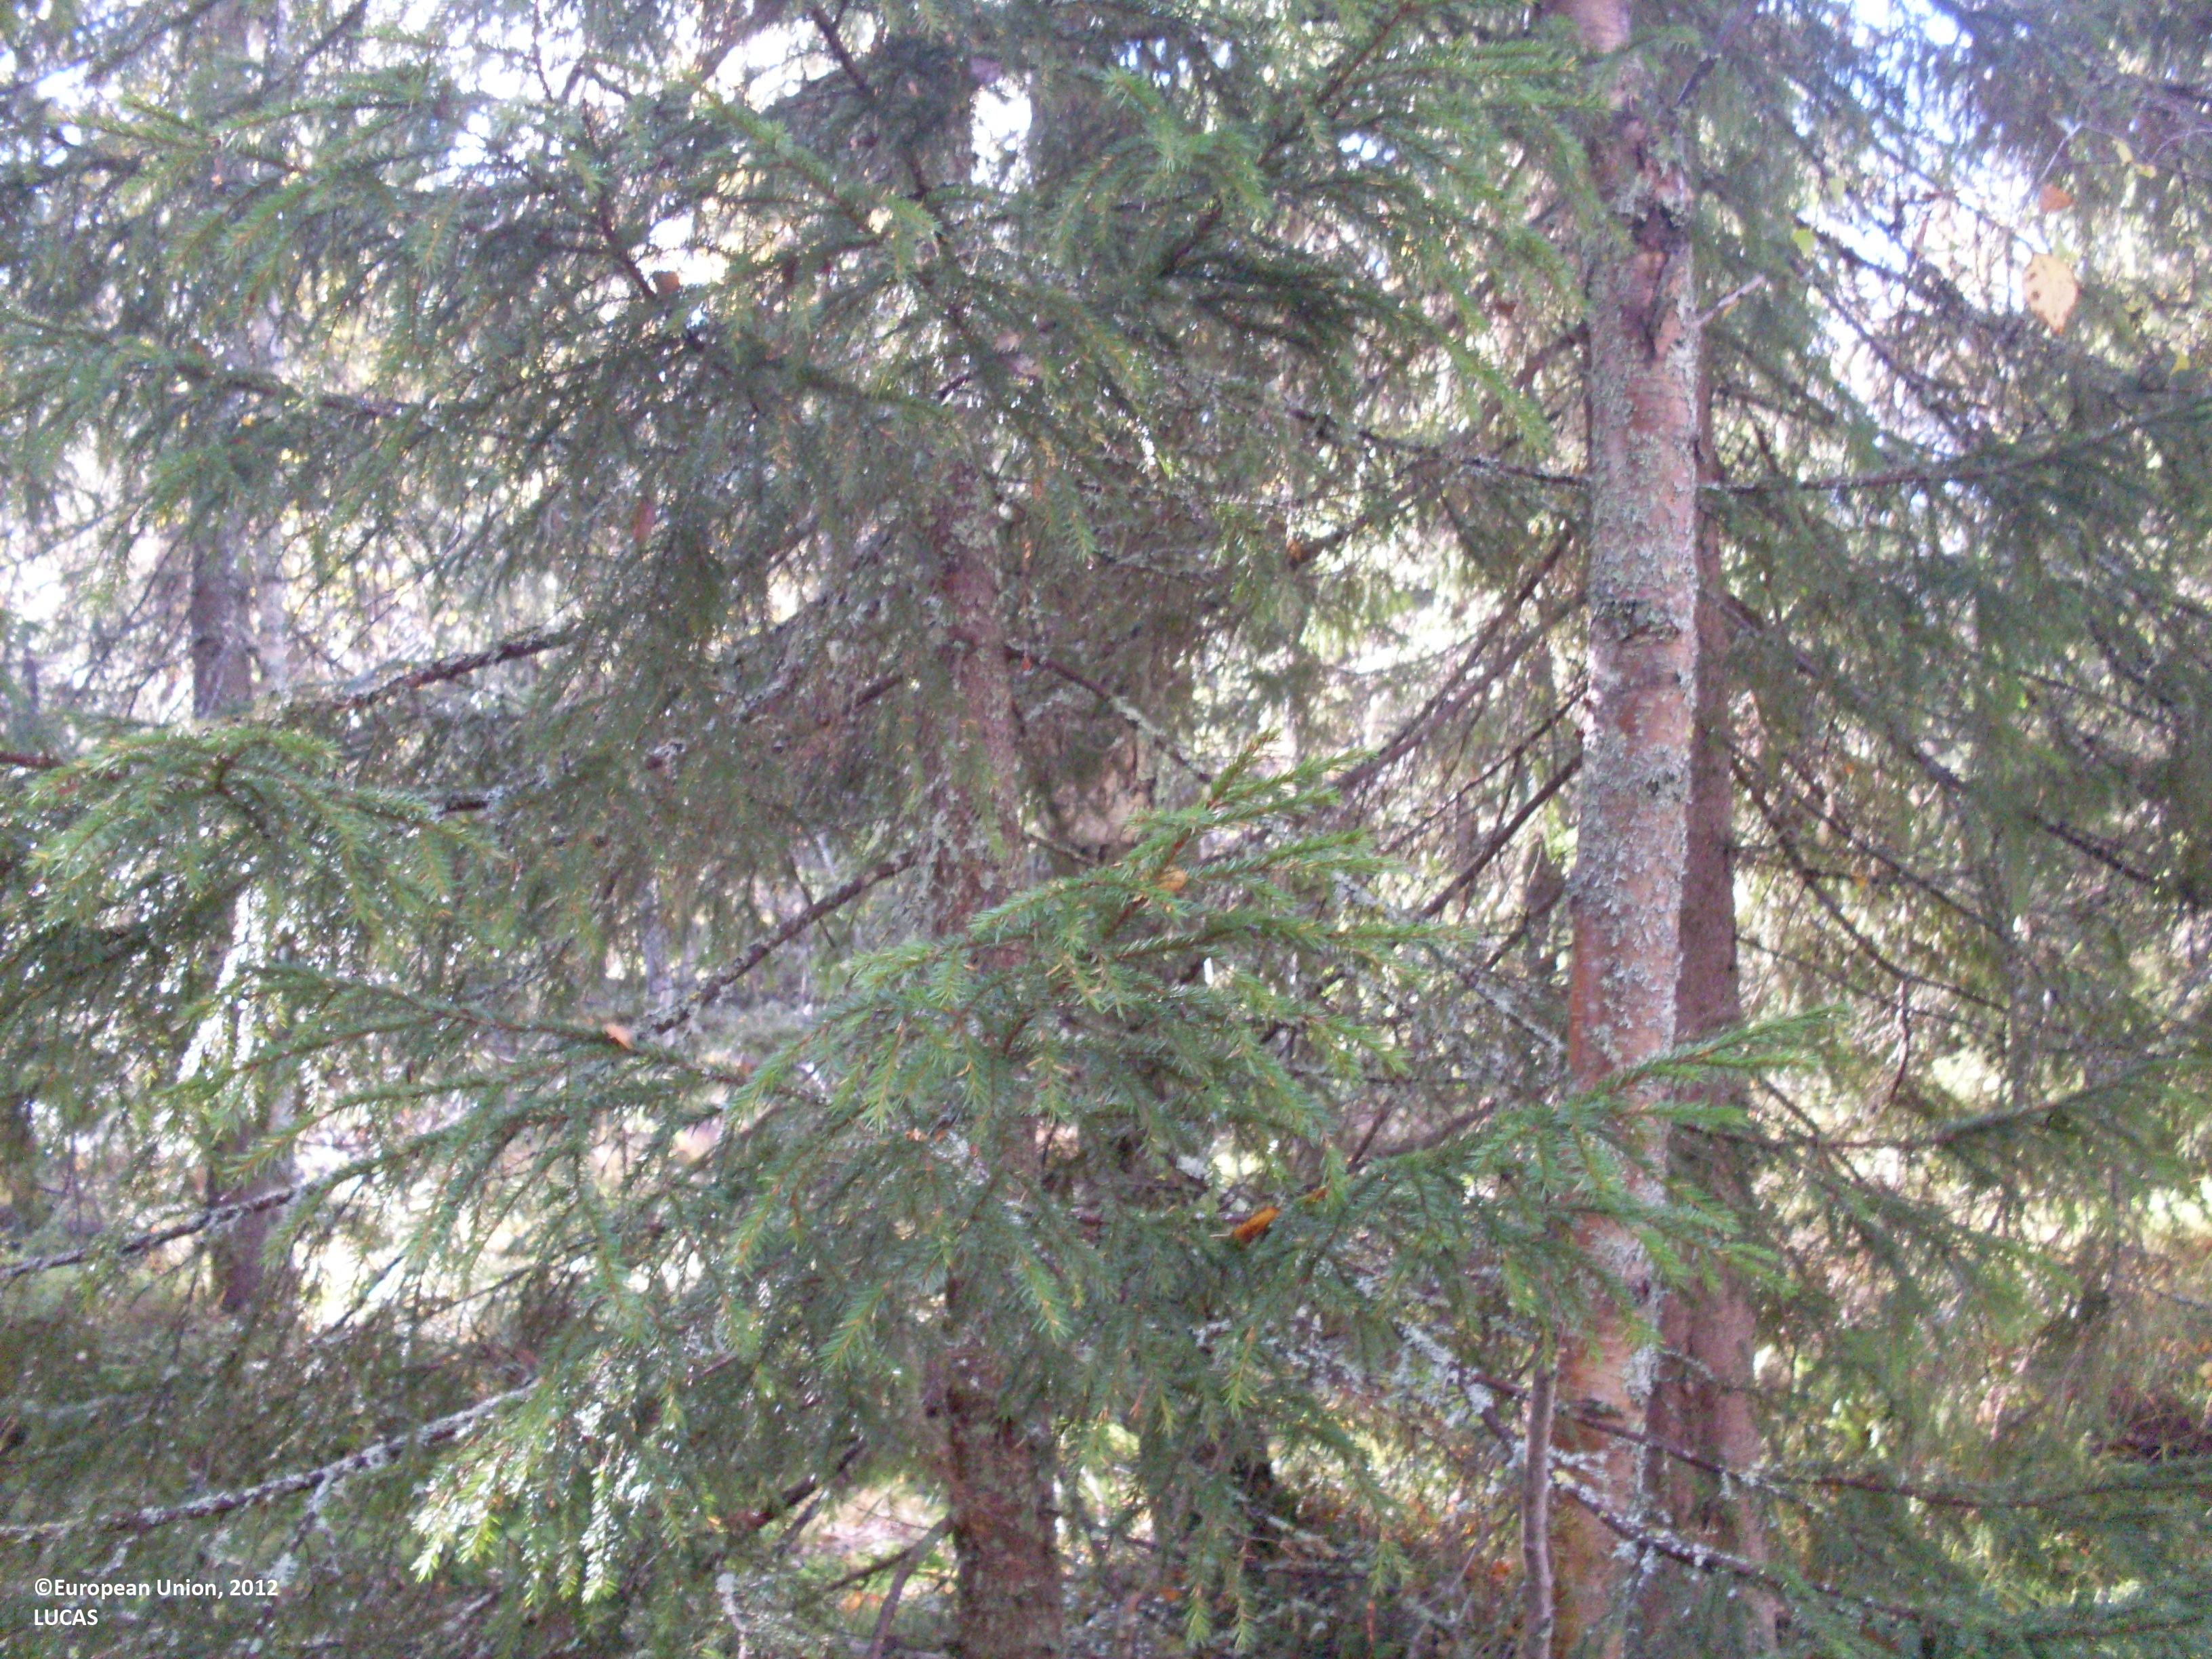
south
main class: Woodland
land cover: Spruce dominated mixed woodland
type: boreal forest
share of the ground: > 75 %
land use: Forestry
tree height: > 5 m
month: September
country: FI
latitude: 64.3326
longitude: 28.4047
